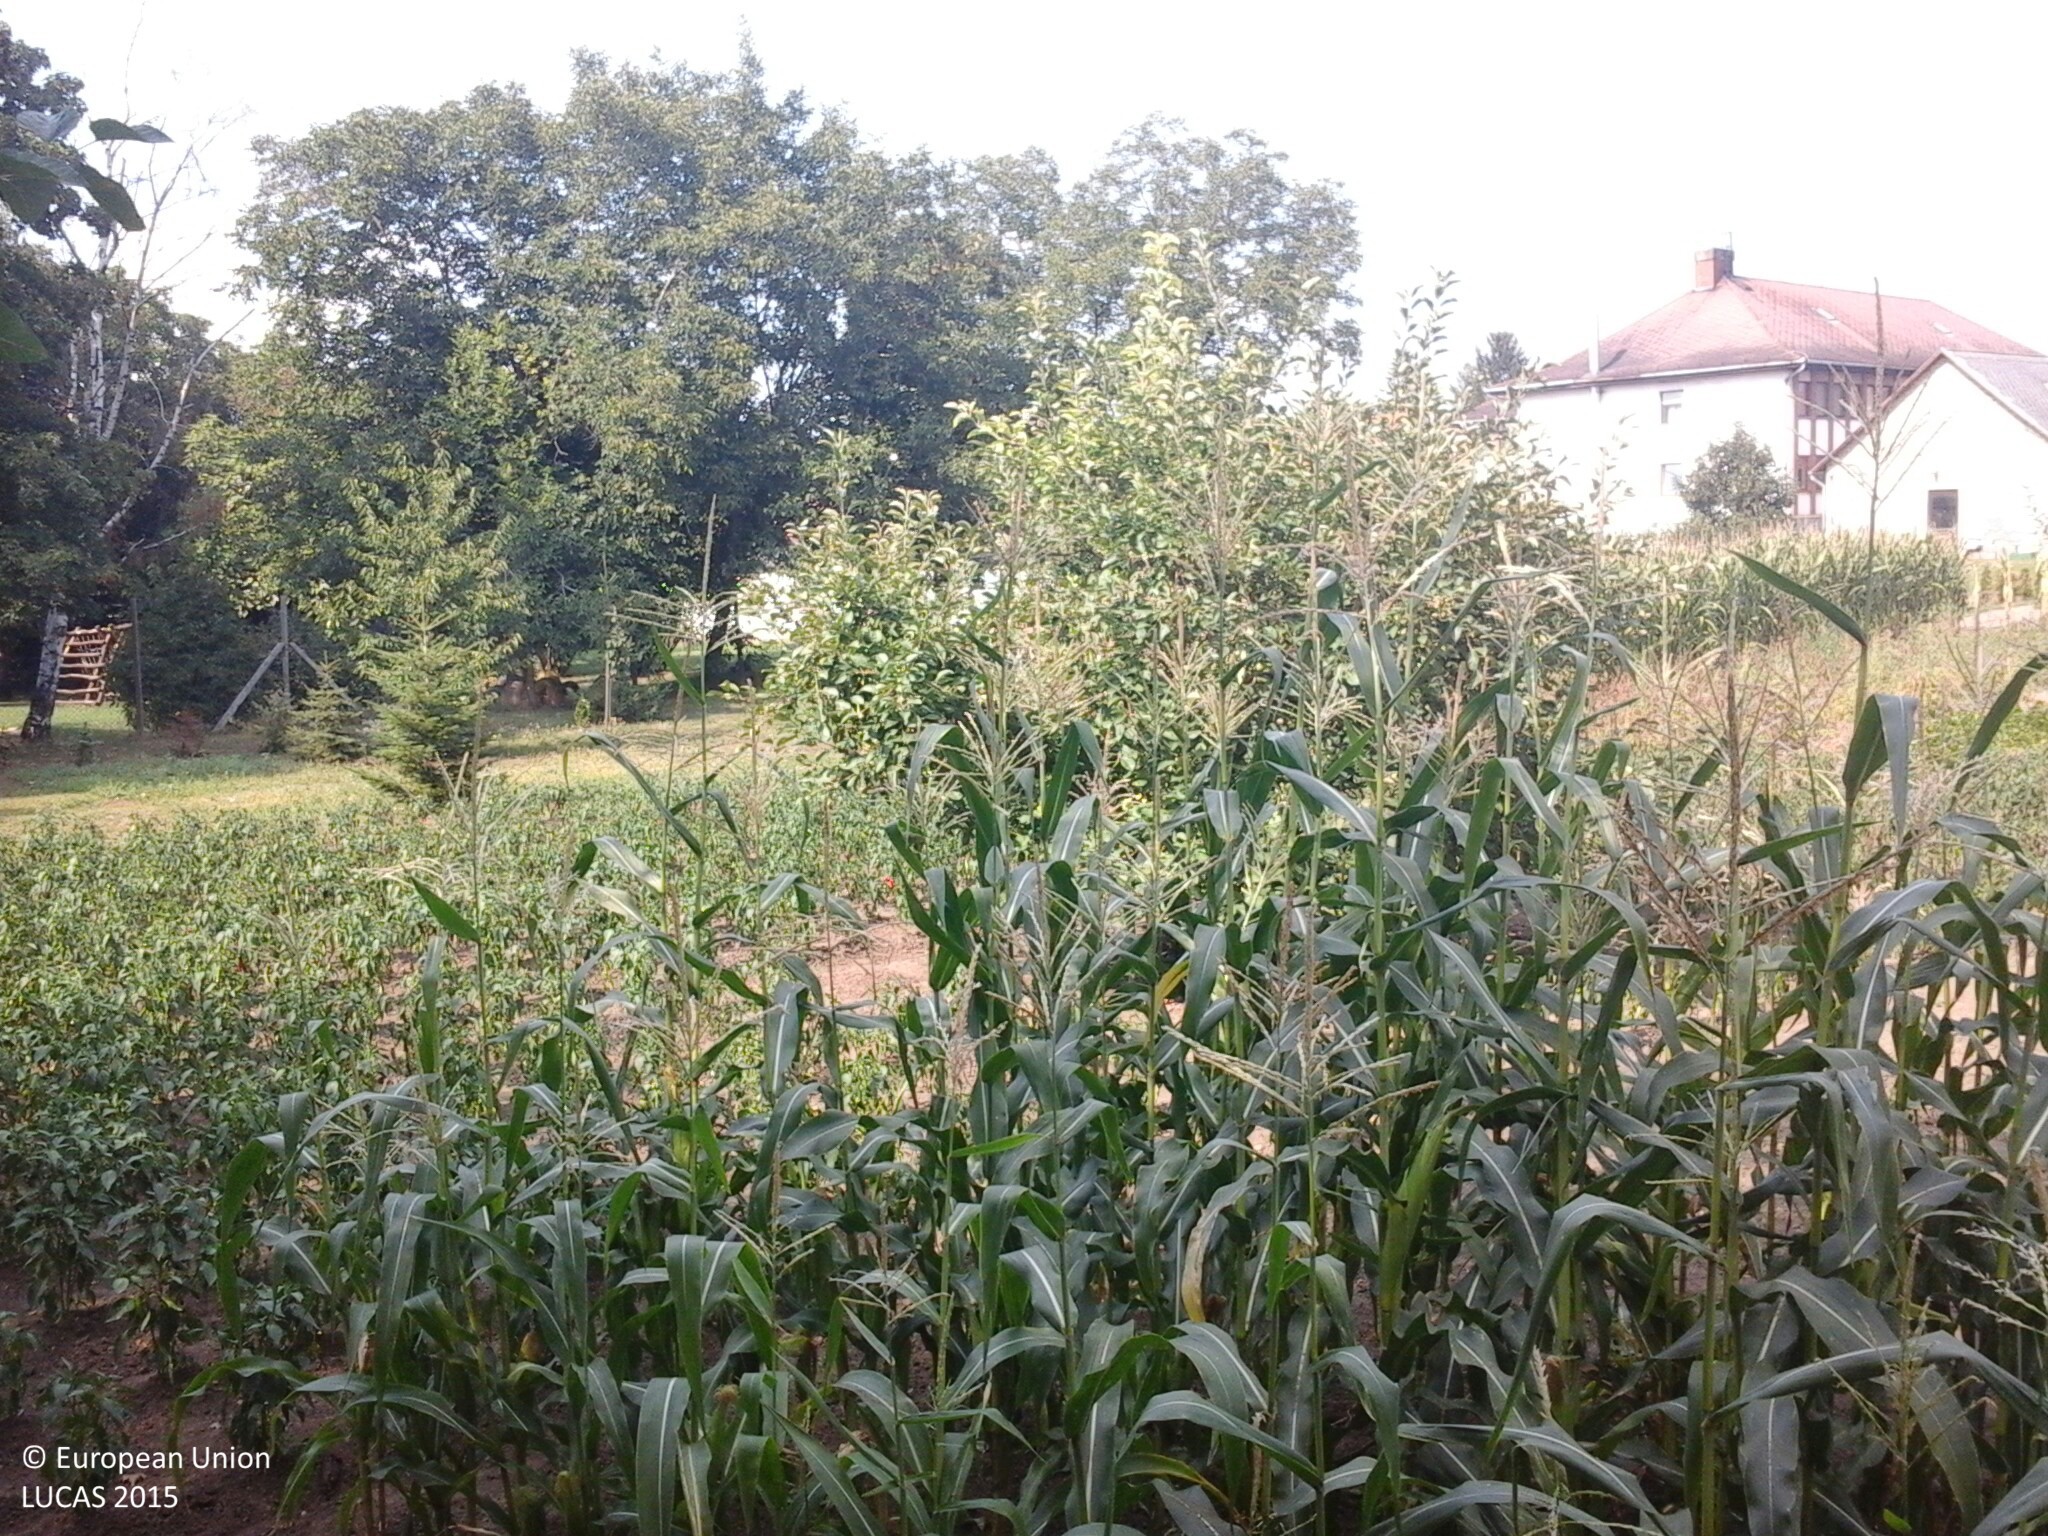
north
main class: Cropland
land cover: Other fresh vegetables
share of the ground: > 75 %
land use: Kitchen garden
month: August
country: HU
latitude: 46.8399
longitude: 18.3367
